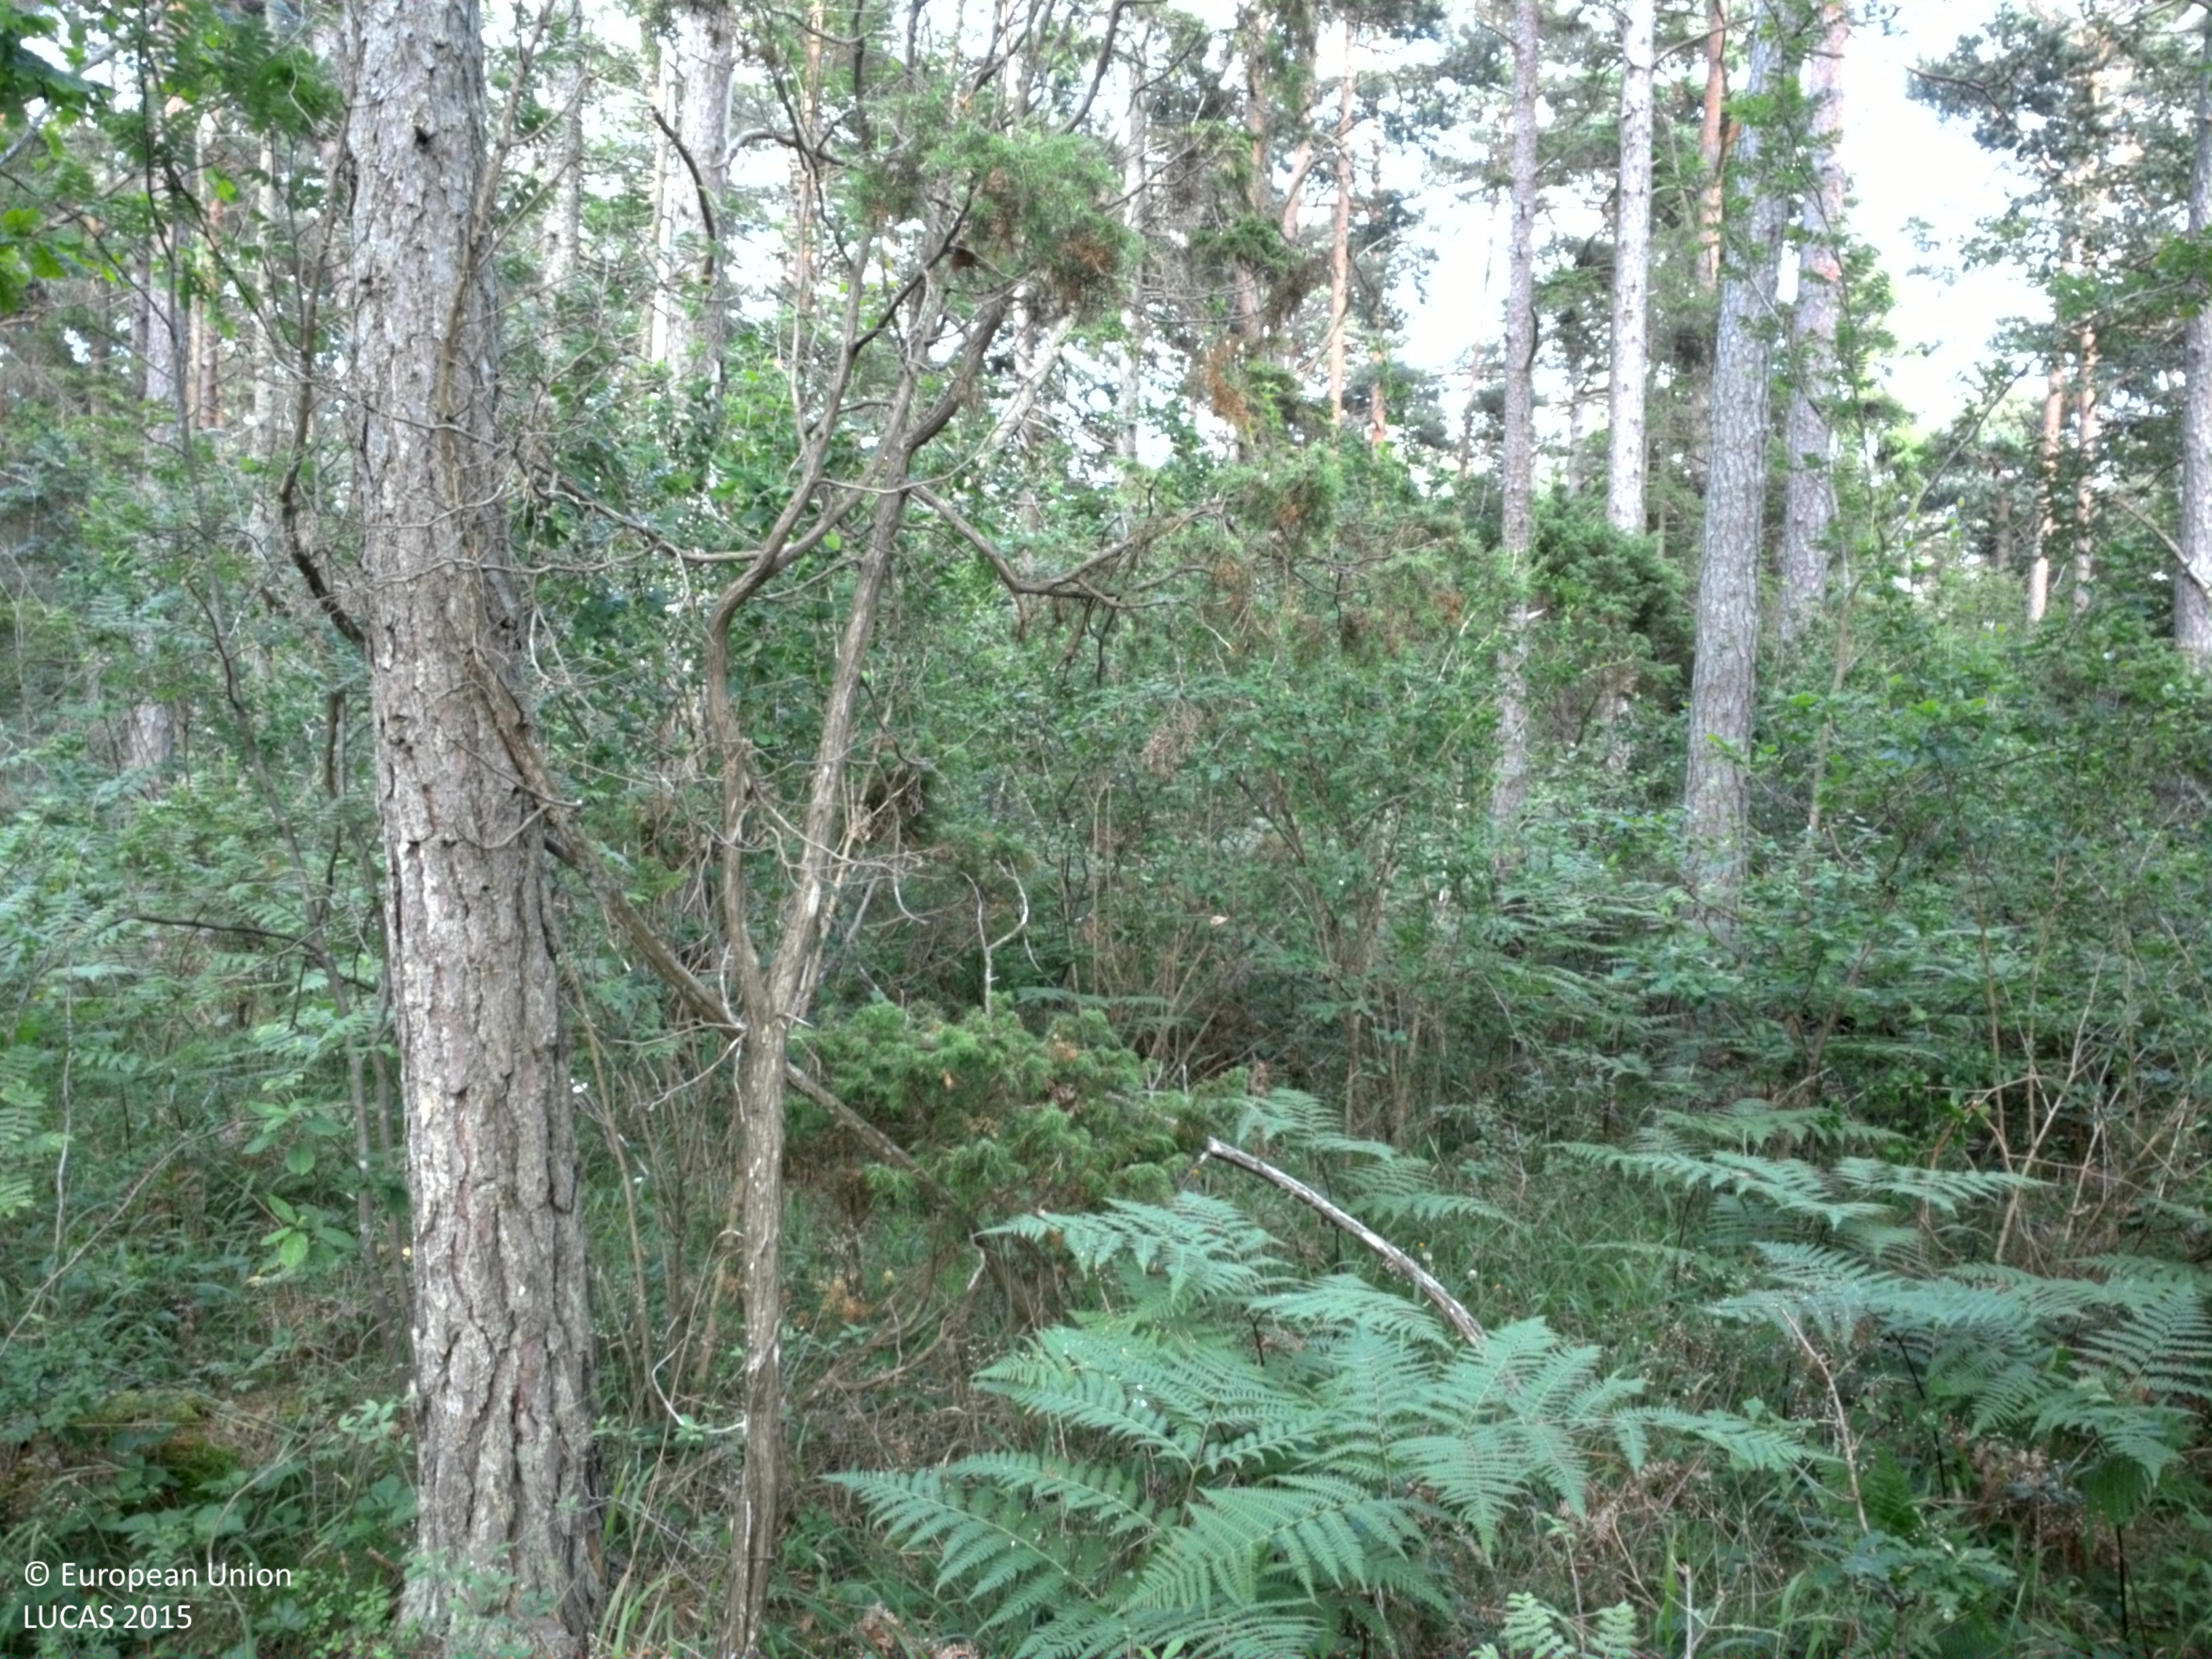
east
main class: Woodland
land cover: Pine dominated coniferous woodland
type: hemiboreal forest and nemoral coniferous forest and mixed broadleaved-coniferous forest
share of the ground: > 75 %
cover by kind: coniferous forest trees 75 %, shrubs 10 %, herbaceous plants 10 %, lichens and mosses 5 %
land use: Forestry
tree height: > 5 m
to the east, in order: Pine dominated coniferous woodland; Tracks; Pine dominated coniferous woodland
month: July
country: SE
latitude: 57.5657
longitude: 18.2821
